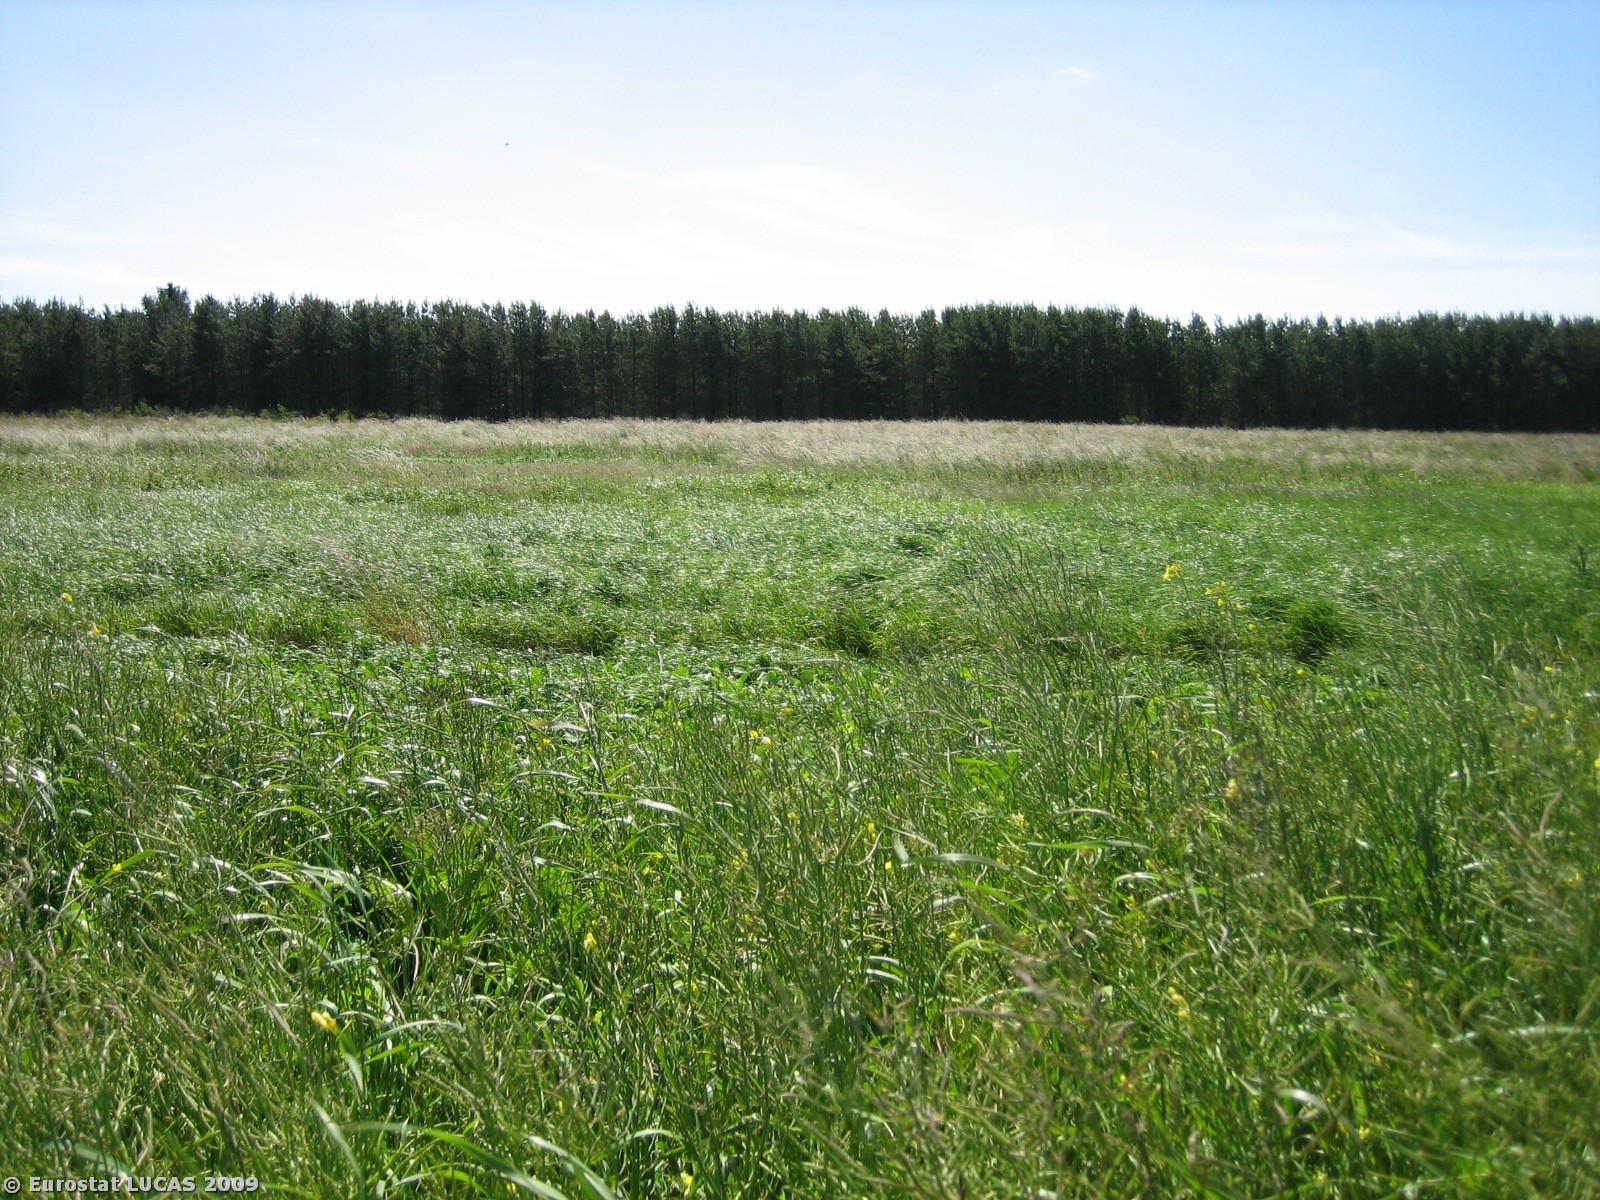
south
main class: Cropland
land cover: Rape and turnip rape
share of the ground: > 75 %
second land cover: Grassland without tree/shrub cover
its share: > 75 %
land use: Agriculture (excluding fallow land and kitchen gardens)
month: June
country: DK
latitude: 55.7384
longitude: 10.0159
